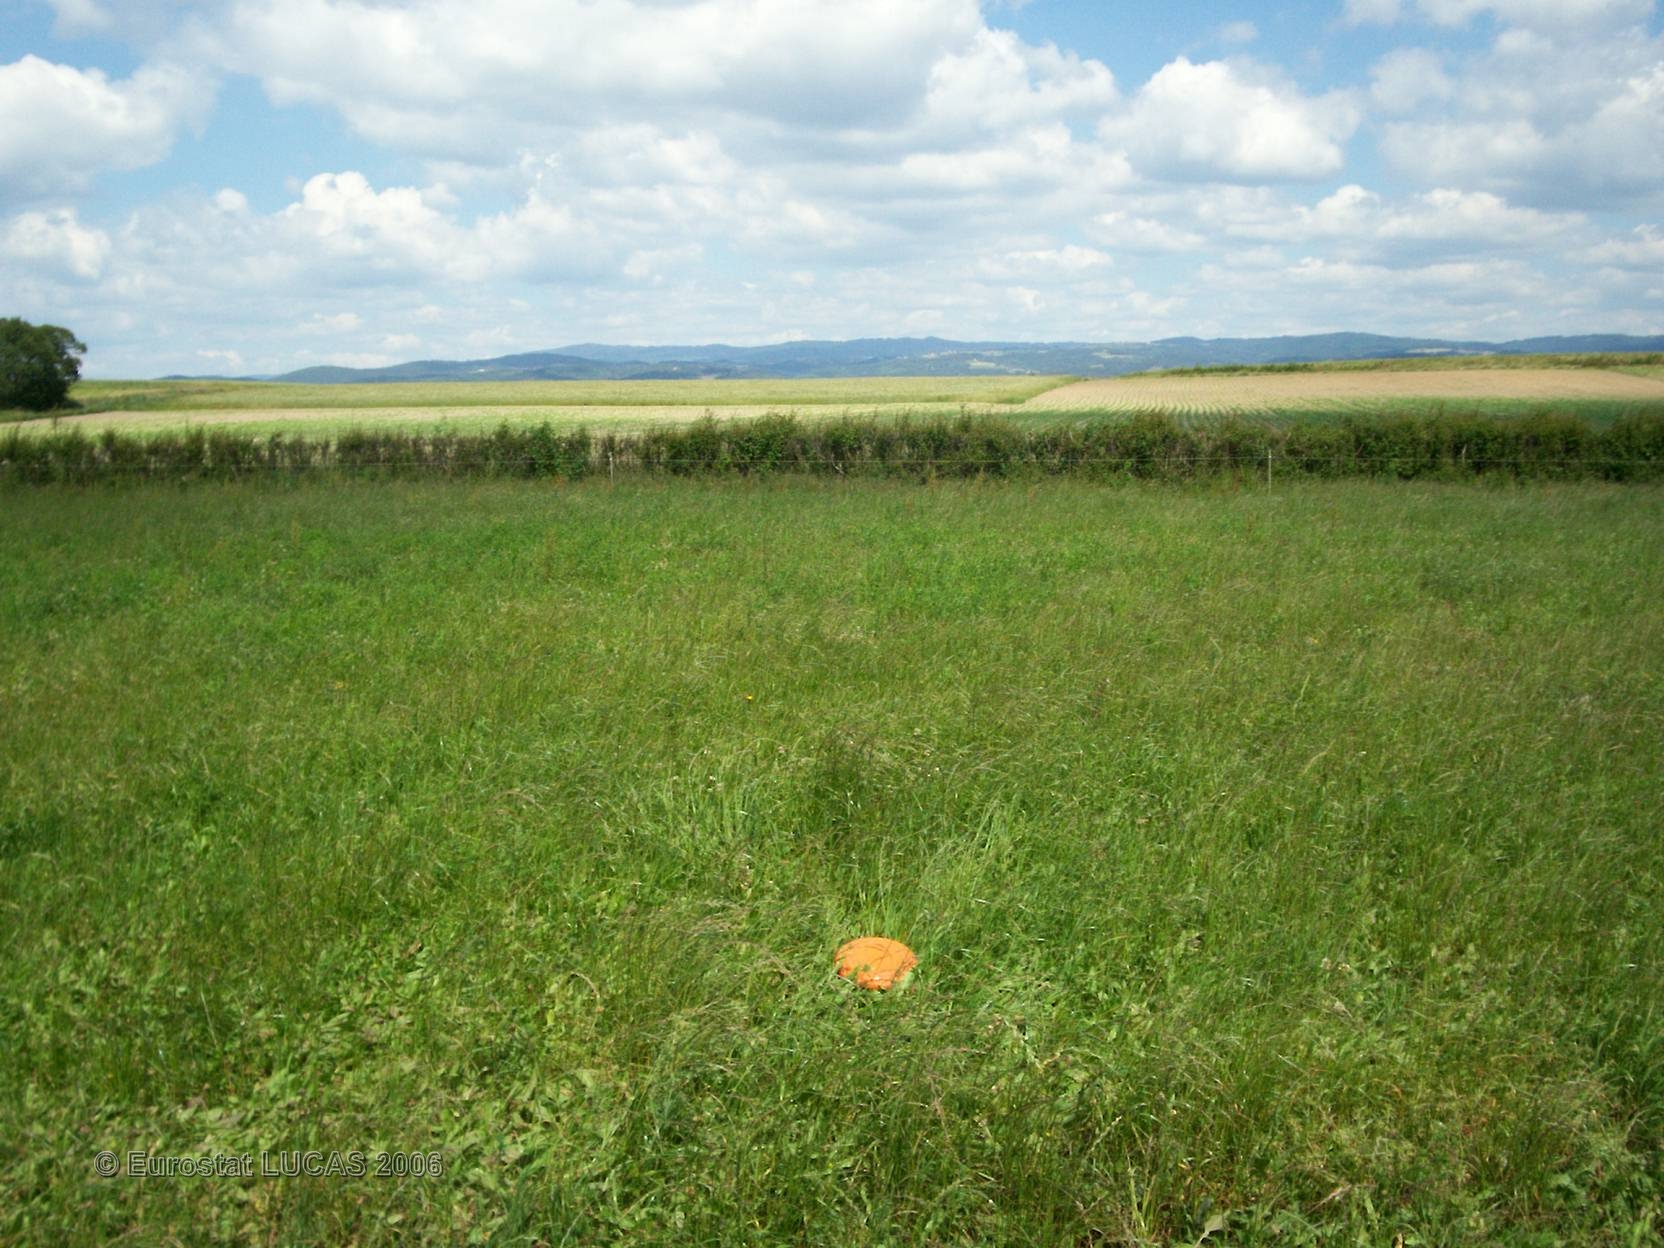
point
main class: Grassland
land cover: Grassland without tree/shrub cover
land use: Agriculture (excluding fallow land and kitchen gardens)
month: June
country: FR
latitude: 45.3474
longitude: 3.3267
